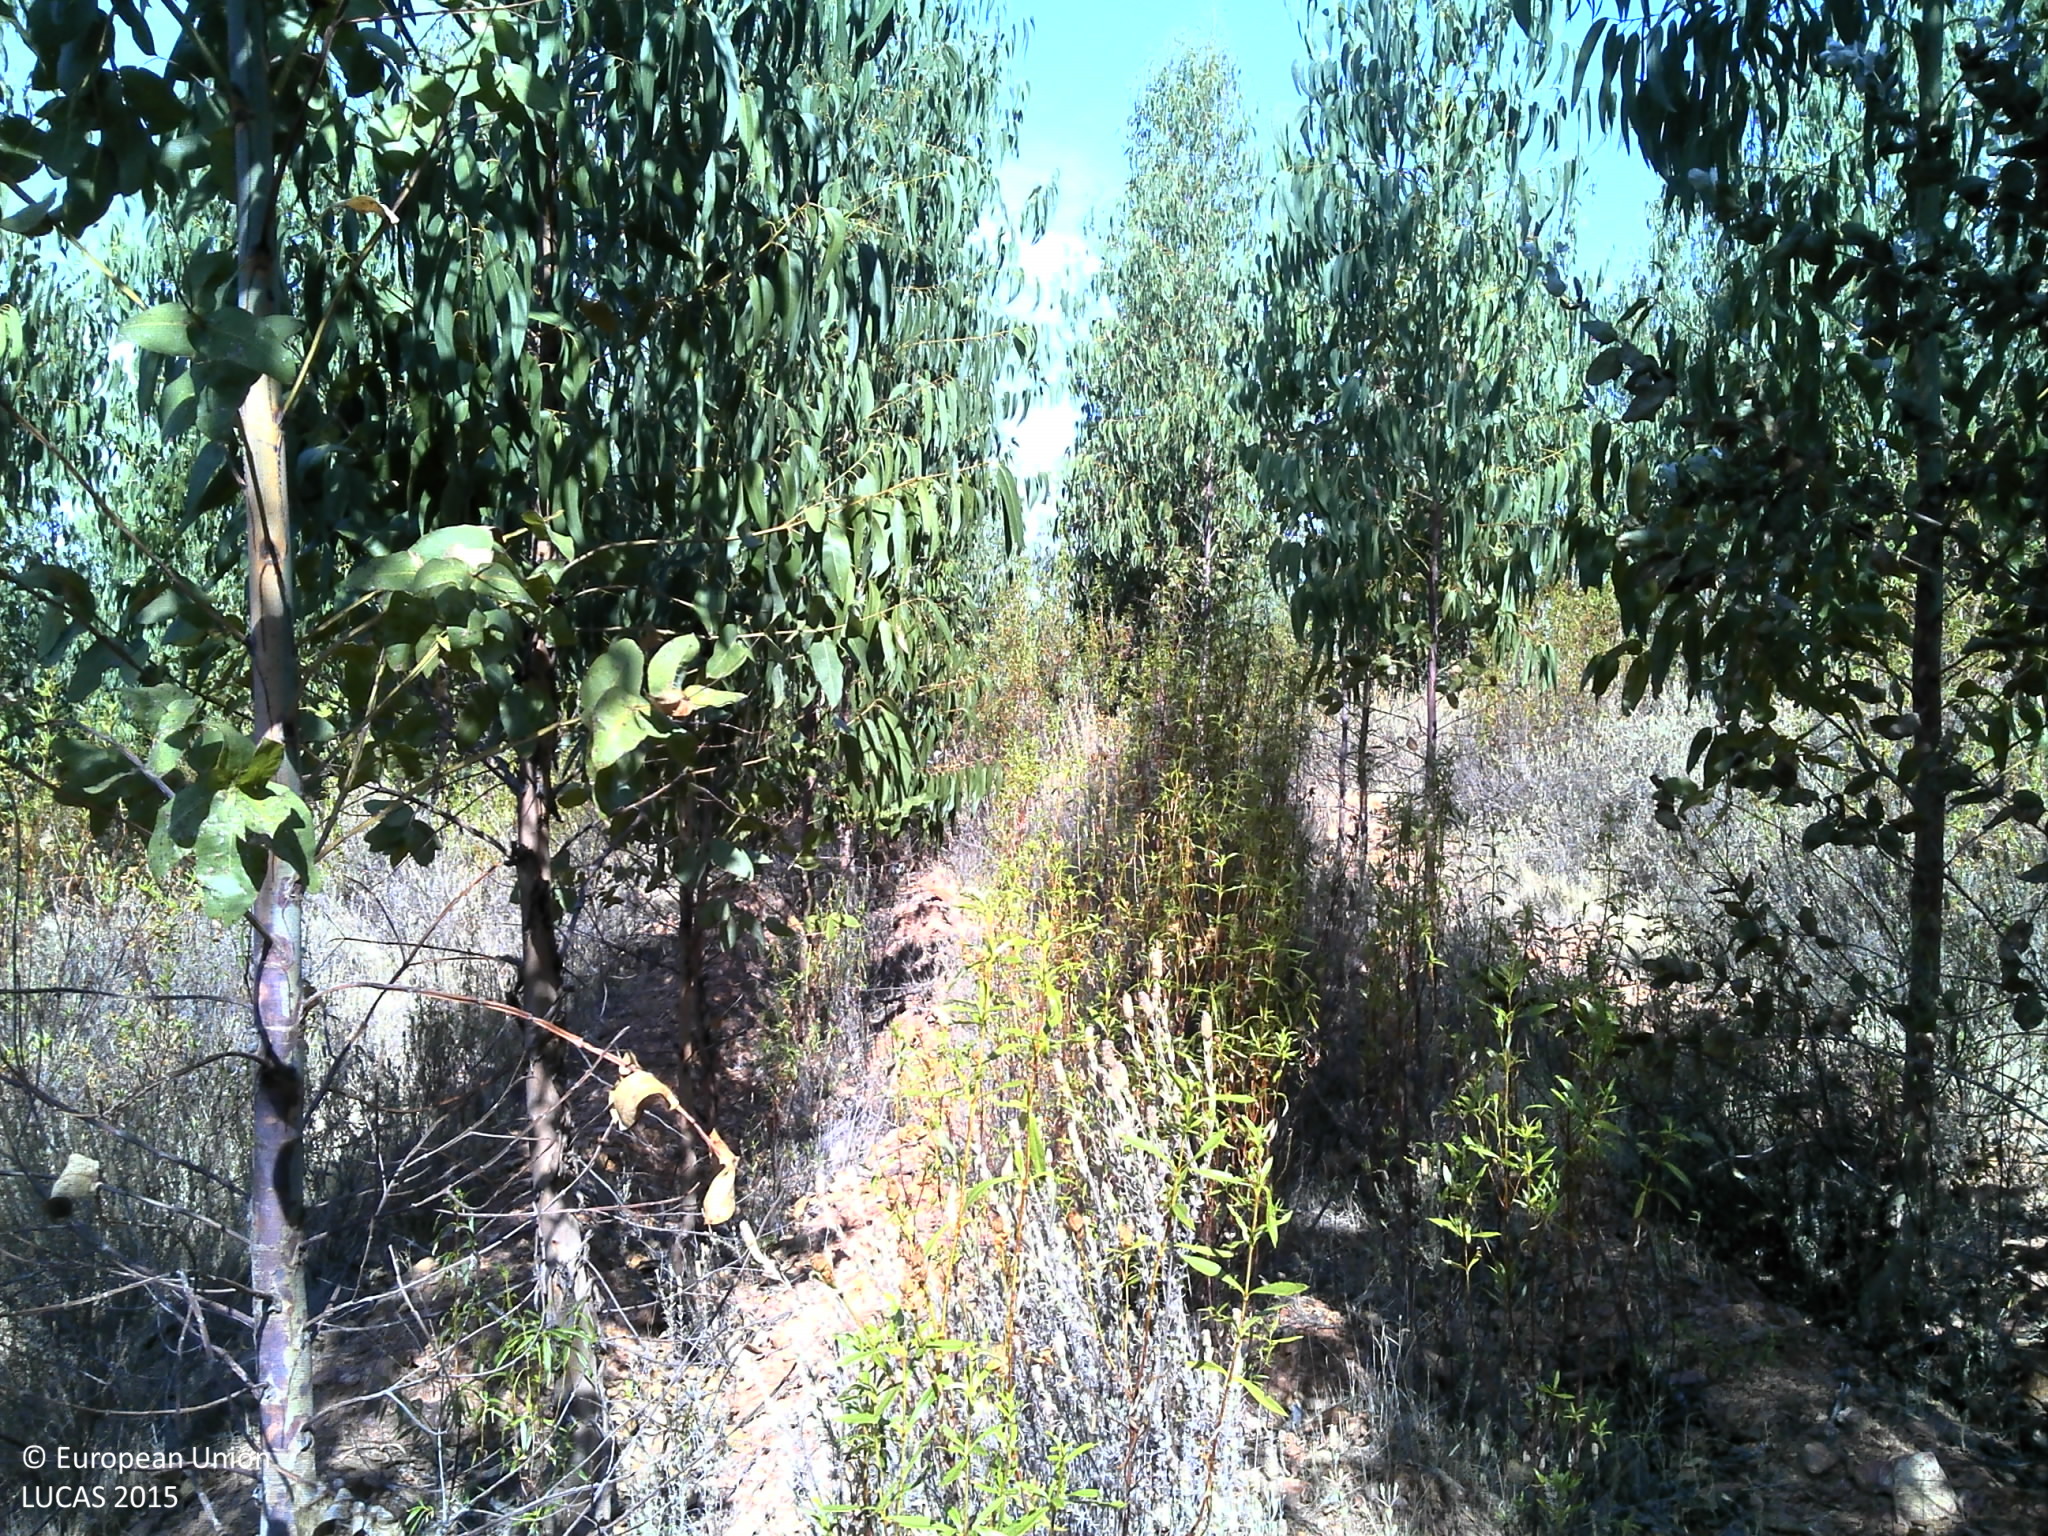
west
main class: Woodland
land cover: Broadleaved woodland
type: exotic forest
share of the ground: 25 - 50 %
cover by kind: broadleaved forest trees 40 %, shrubs 40 %, unconsolidated bare surface 20 %
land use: Forestry
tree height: > 5 m
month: July
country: PT
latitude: 38.6114
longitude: -7.4744
